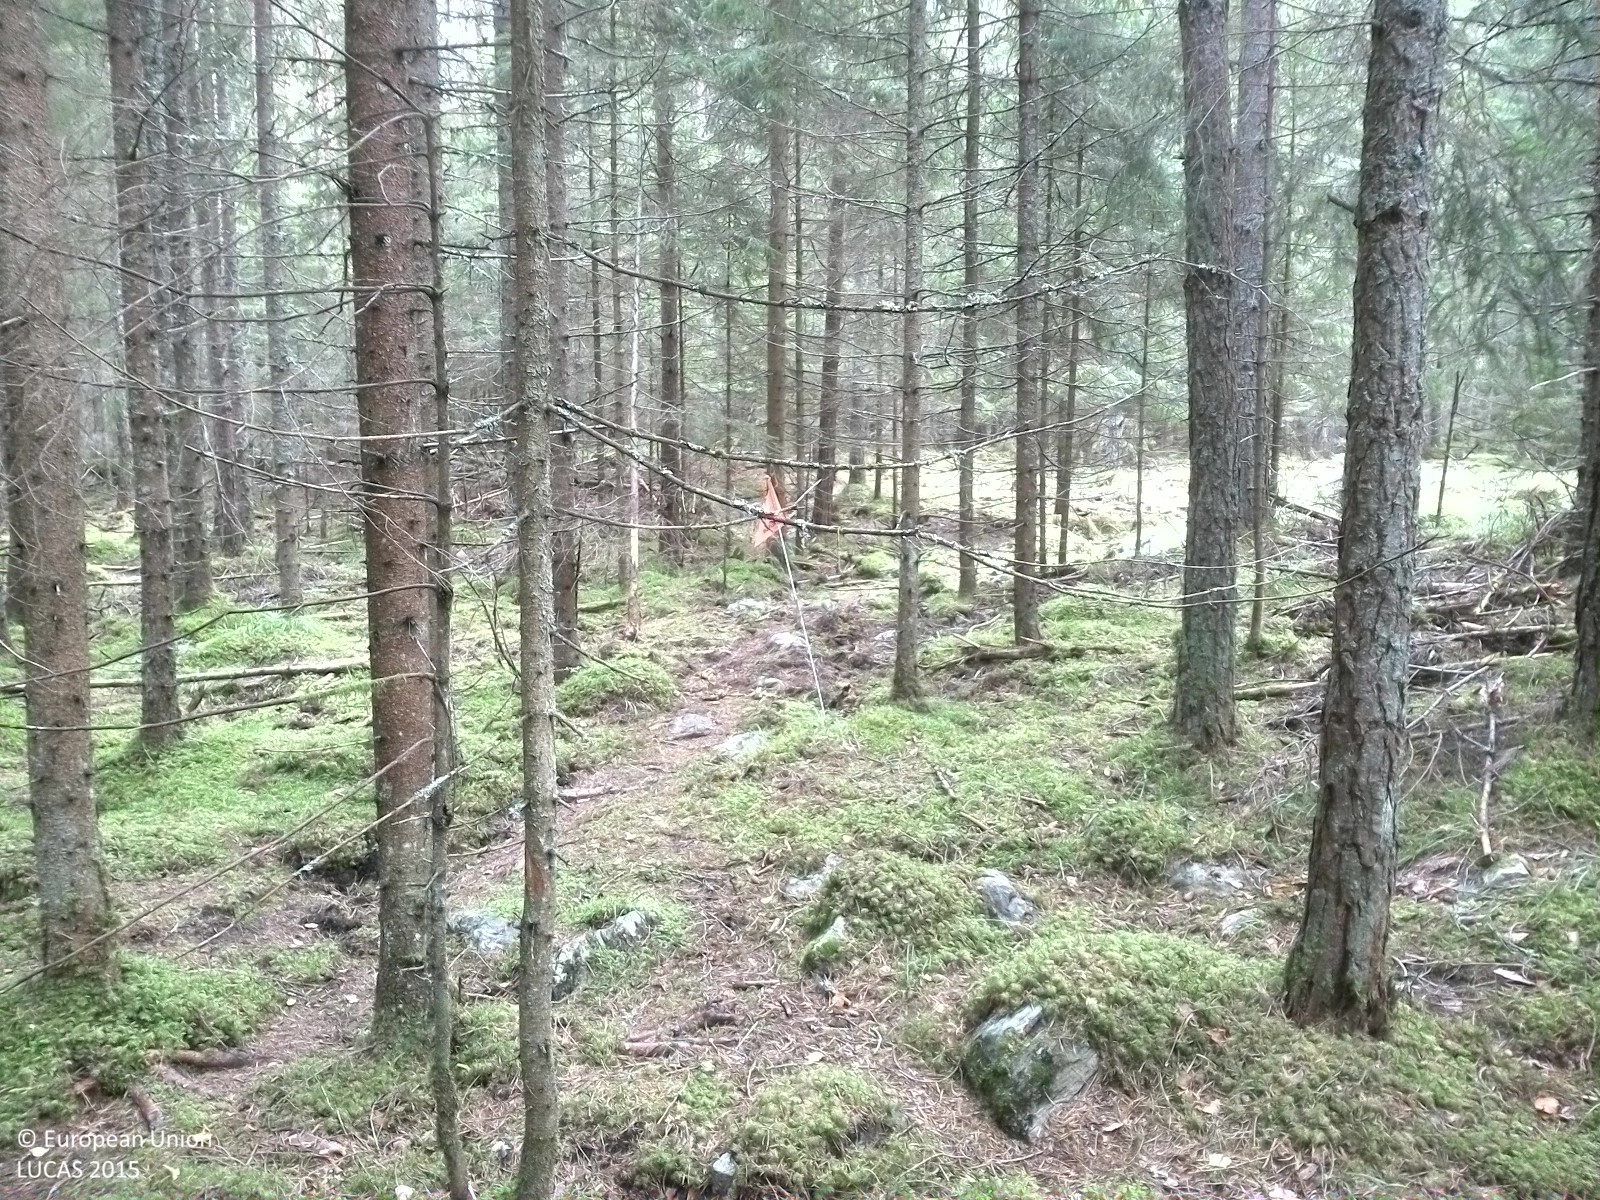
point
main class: Woodland
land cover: Spruce dominated coniferous woodland
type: boreal forest
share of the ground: 50 - 75 %
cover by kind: coniferous forest trees 60 %, lichens and mosses 30 %, herbaceous plants 5 %, unconsolidated bare surface 5 %
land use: Forestry
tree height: > 5 m
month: August
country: SE
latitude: 58.7876
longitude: 15.6163
